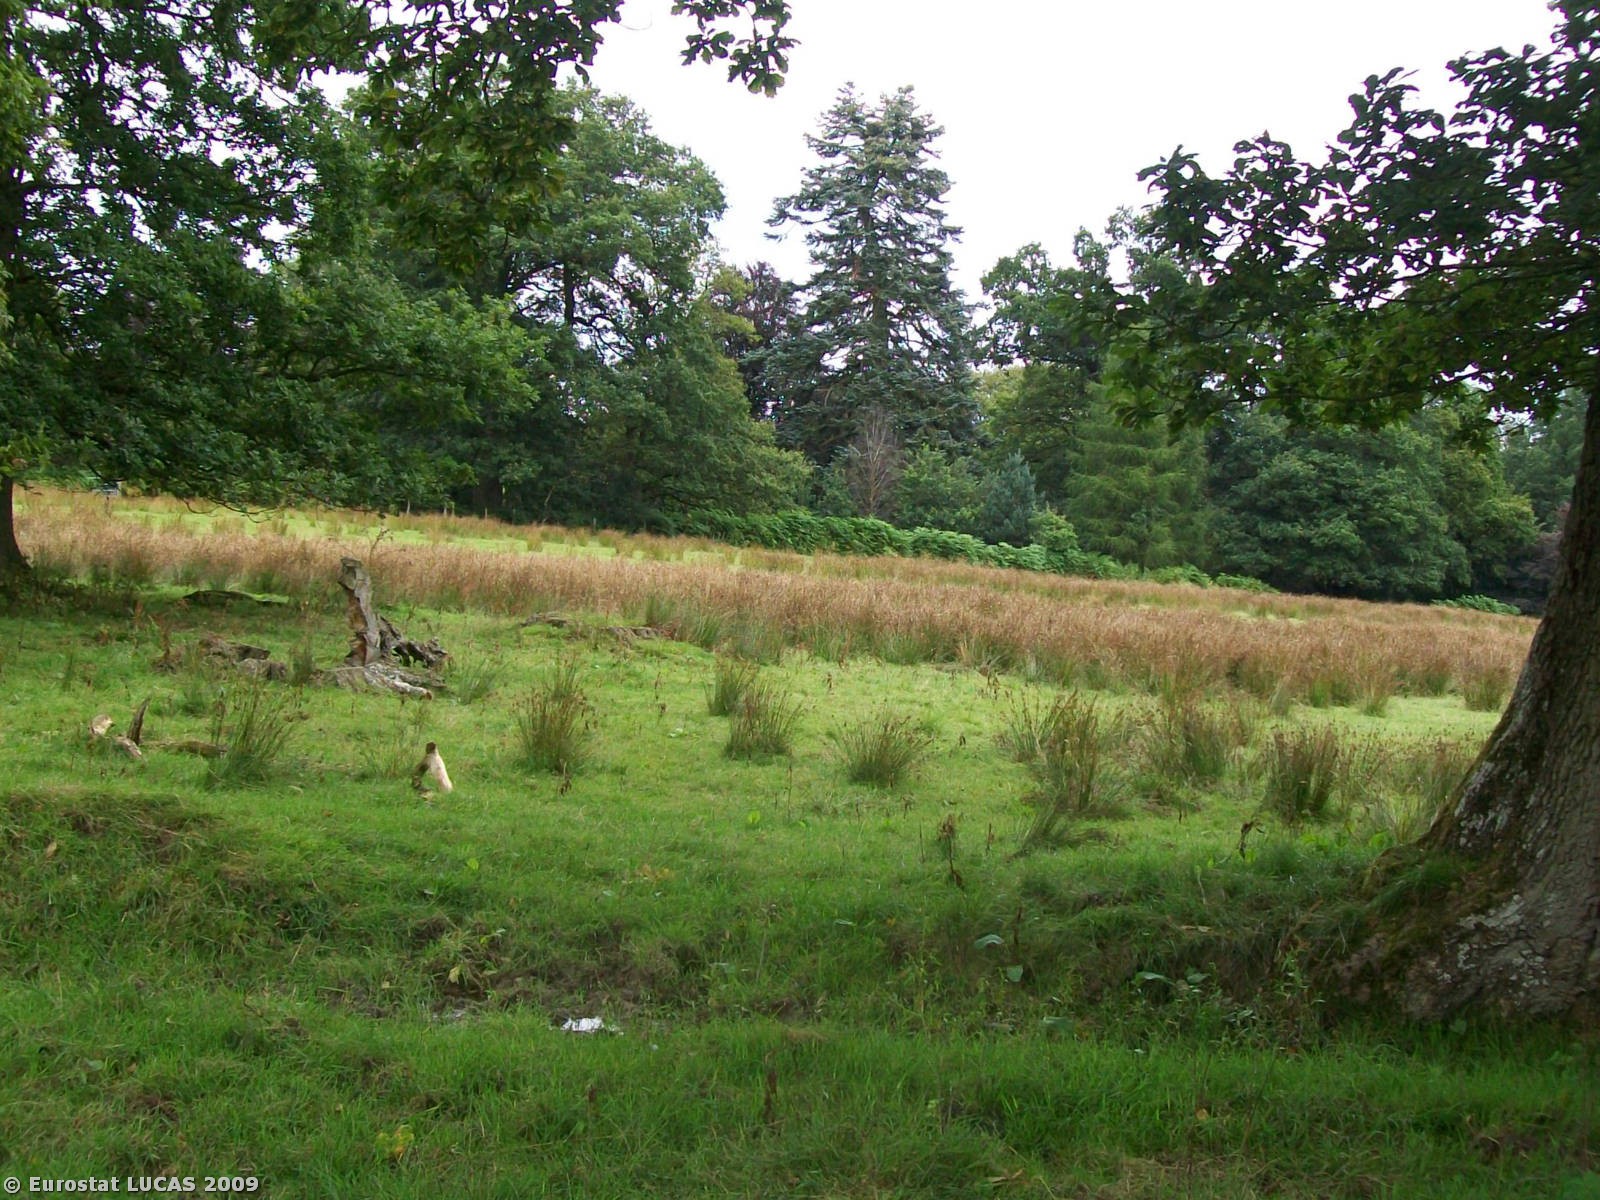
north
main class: Grassland
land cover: Grassland with sparse tree/shrub cover
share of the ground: > 75 %
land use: Agriculture (excluding fallow land and kitchen gardens)
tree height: > 5 m
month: August
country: GB
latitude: 52.5678
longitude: -3.3448
